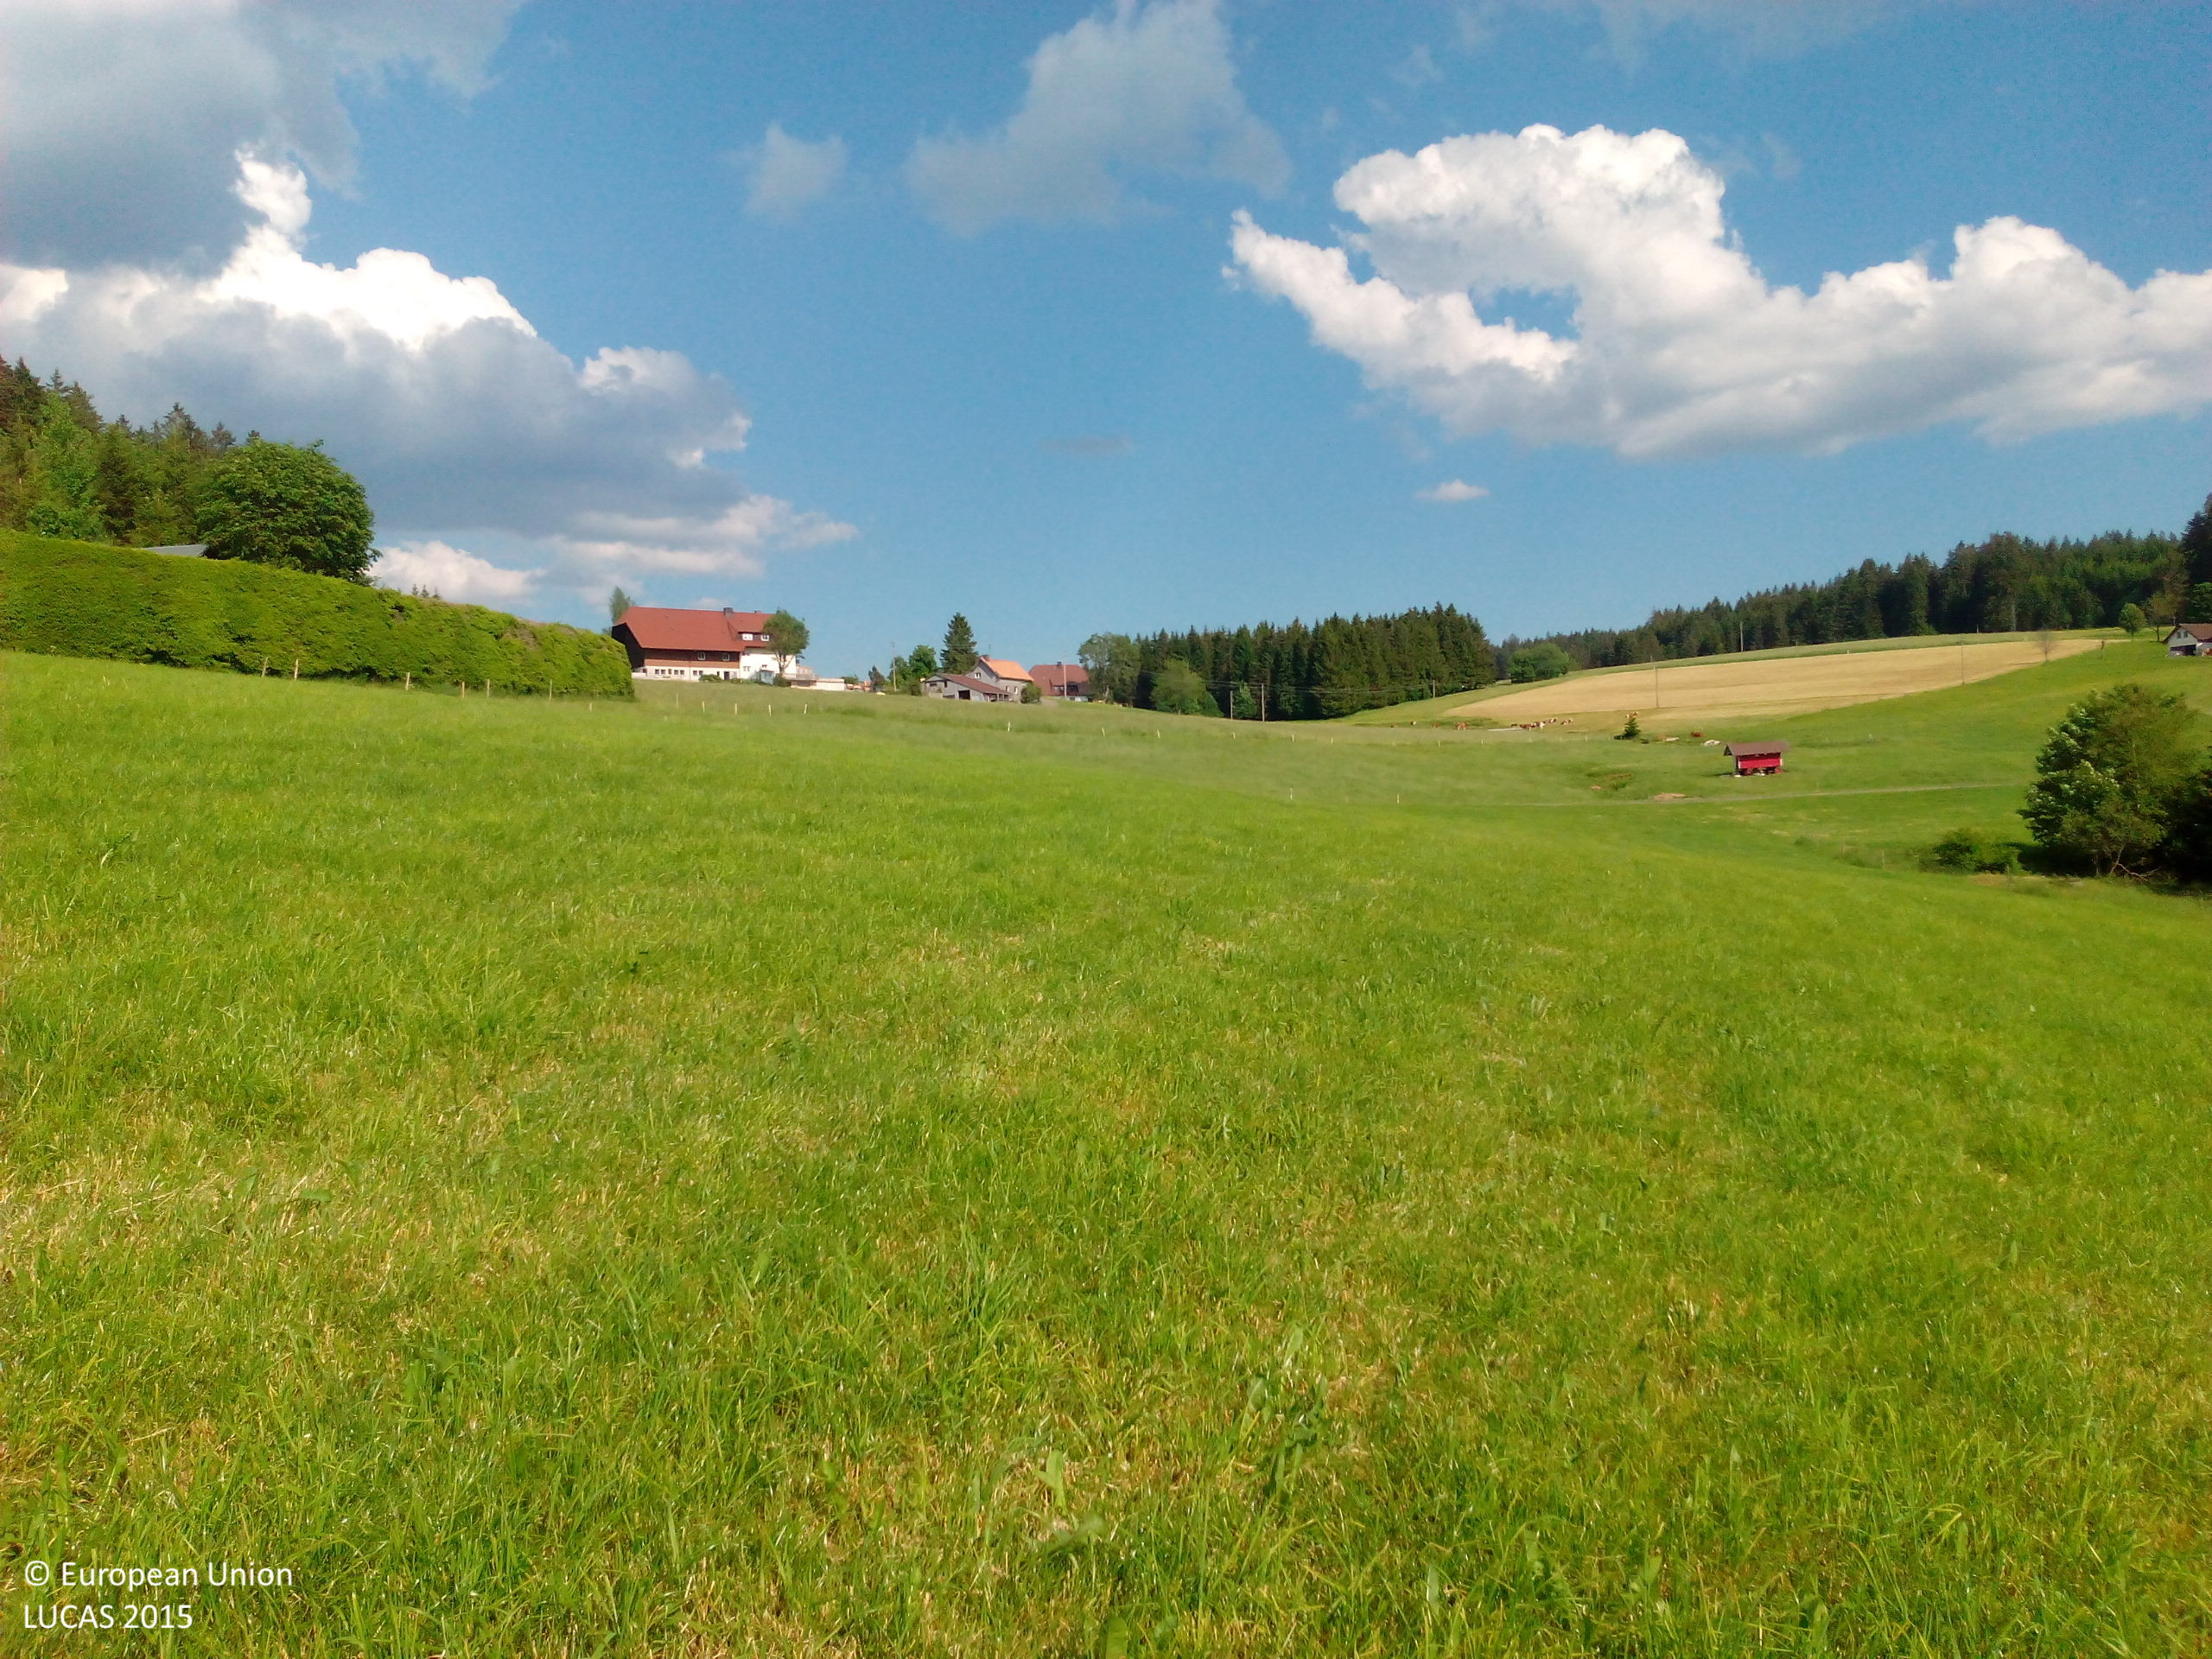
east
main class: Grassland
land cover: Grassland without tree/shrub cover
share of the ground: > 75 %
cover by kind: herbaceous plants 100 %
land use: Agriculture (excluding fallow land and kitchen gardens)
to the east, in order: Grassland without tree/shrub cover; Tracks; Grass margins; Fences; Grass margins; Artificial constructions in urban areas; Grassland without tree/shrub cover; Spruce dominated coniferous woodland
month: June
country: DE
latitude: 47.9734
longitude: 8.1123
